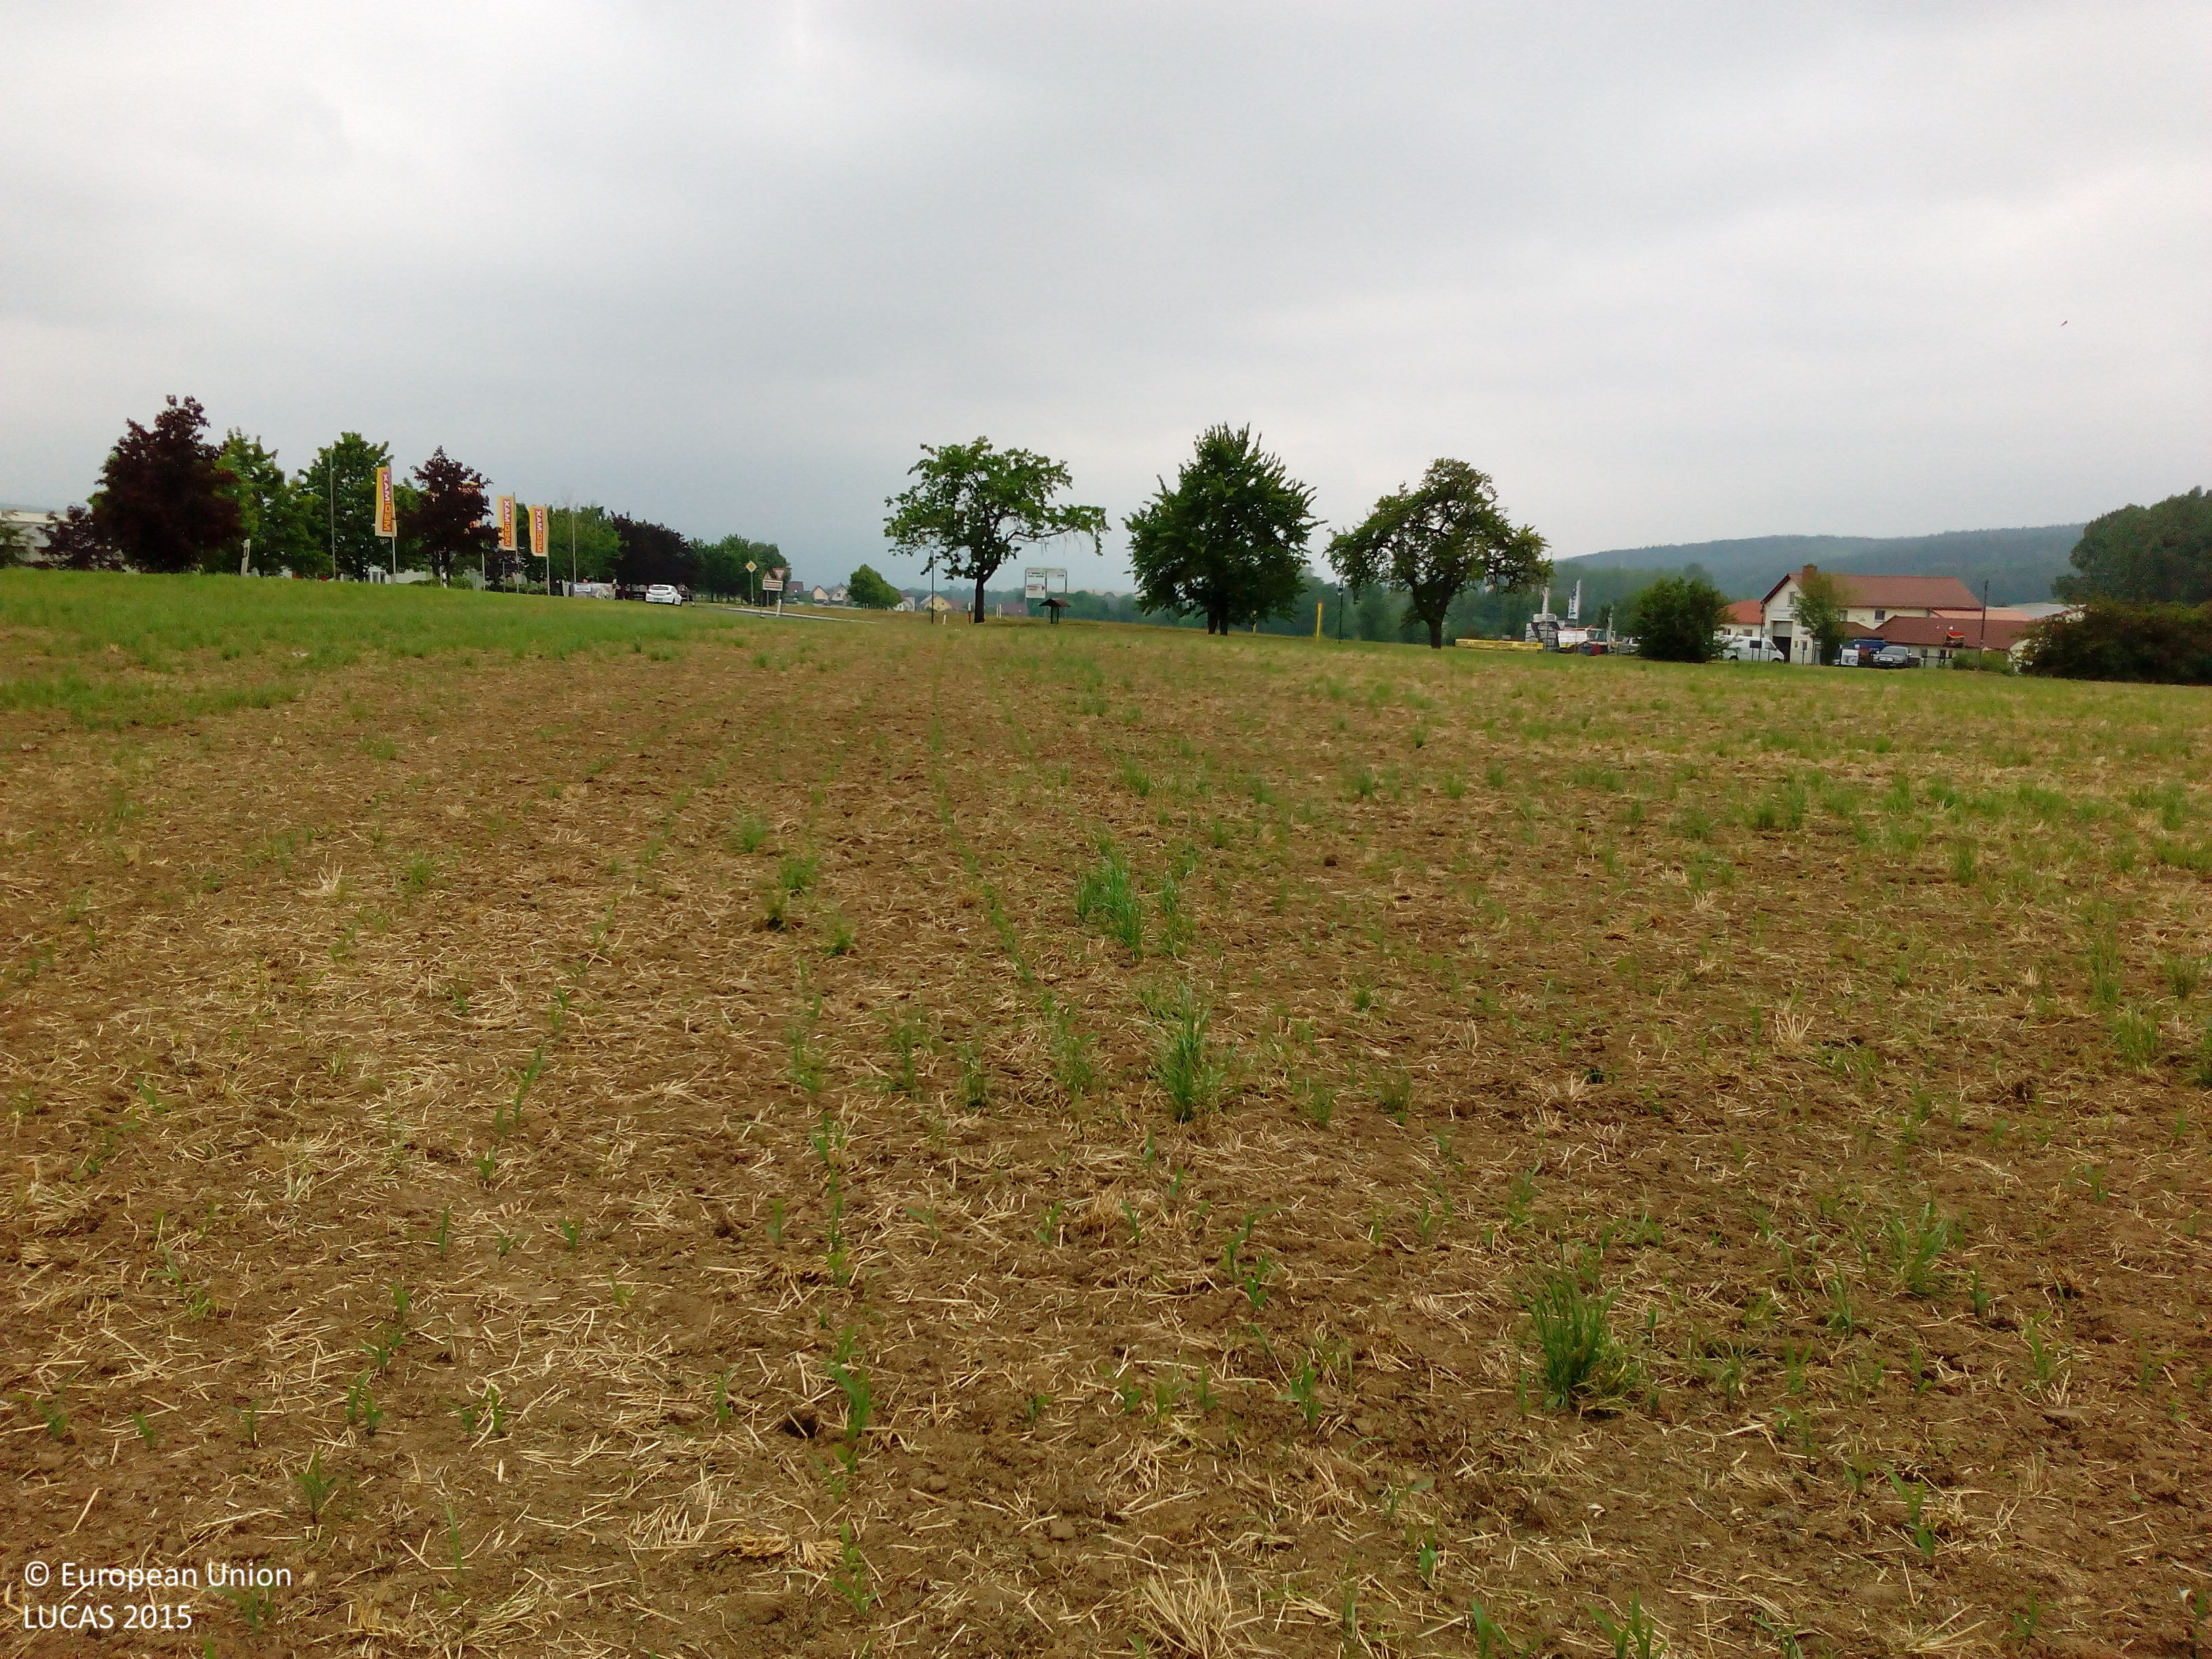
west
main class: Cropland
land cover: Maize
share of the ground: < 10 %
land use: Agriculture (excluding fallow land and kitchen gardens)
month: June
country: DE
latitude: 50.6605
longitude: 11.4567
